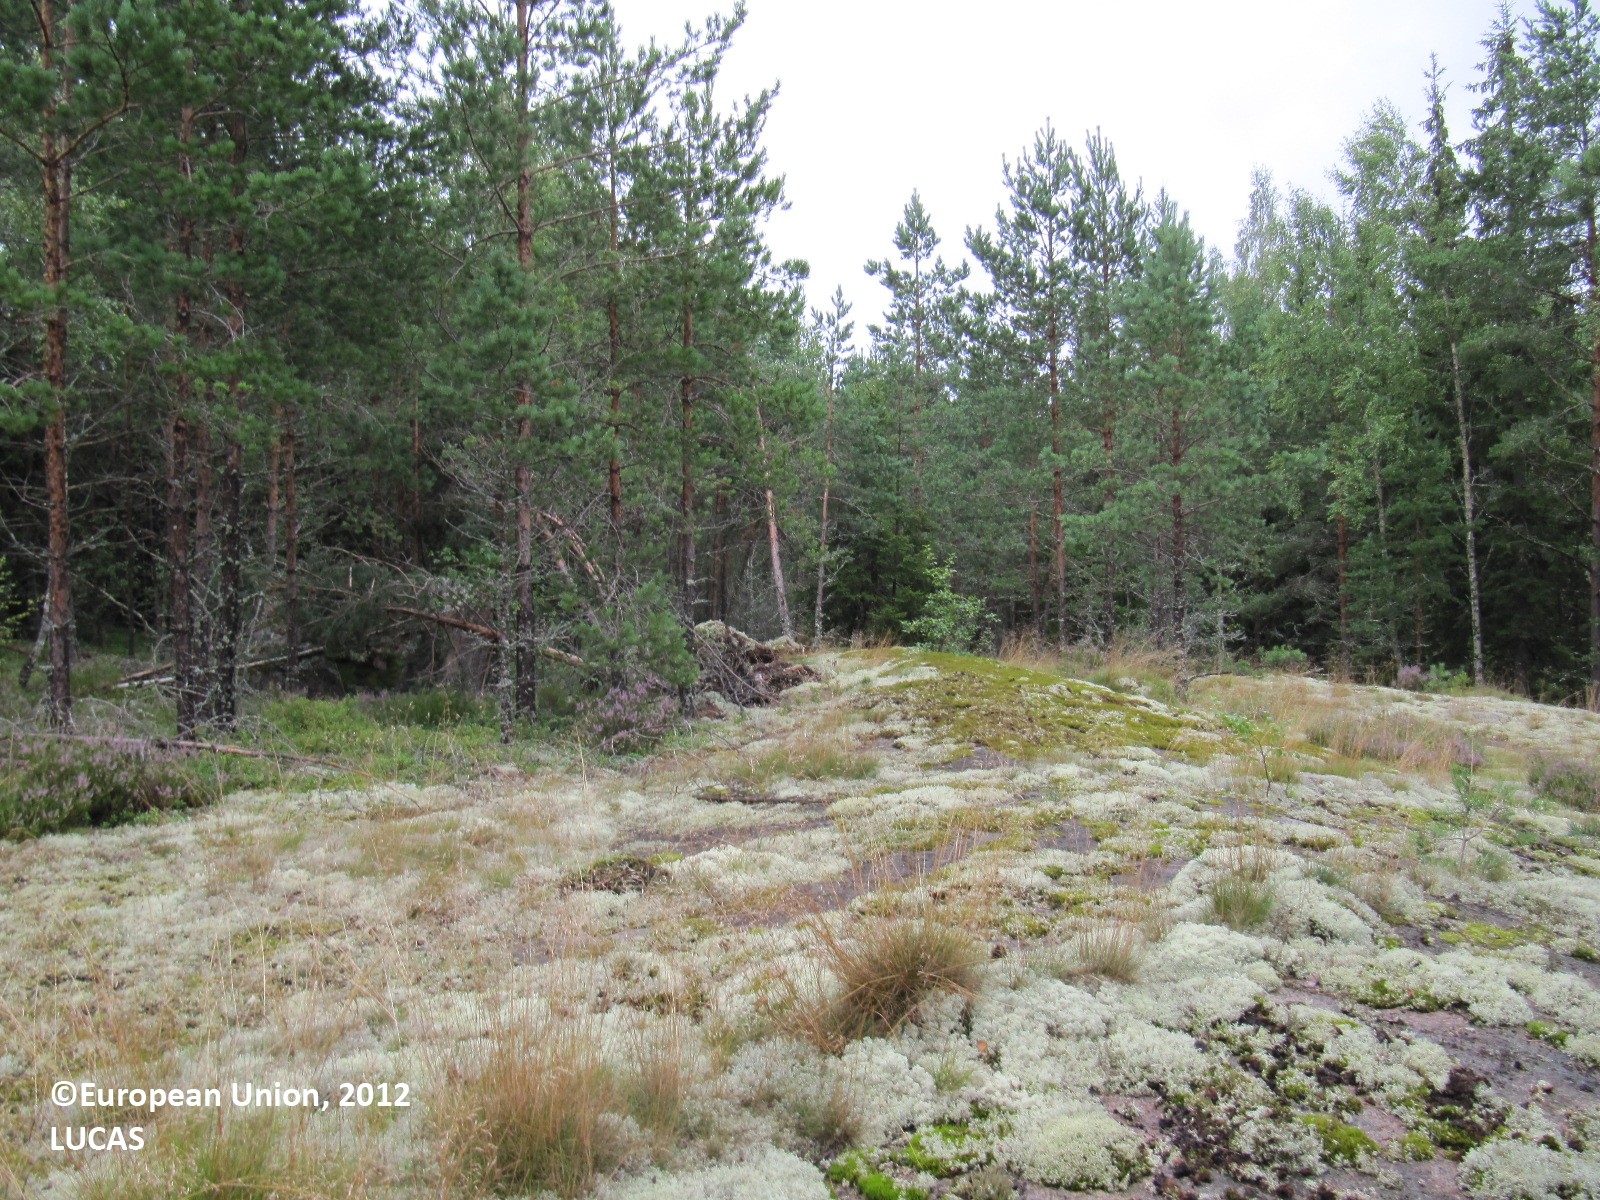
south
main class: Woodland
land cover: Pine dominated coniferous woodland
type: boreal forest
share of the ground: 50 - 75 %
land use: Forestry
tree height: > 5 m
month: August
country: FI
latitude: 60.2843
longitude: 23.0476
